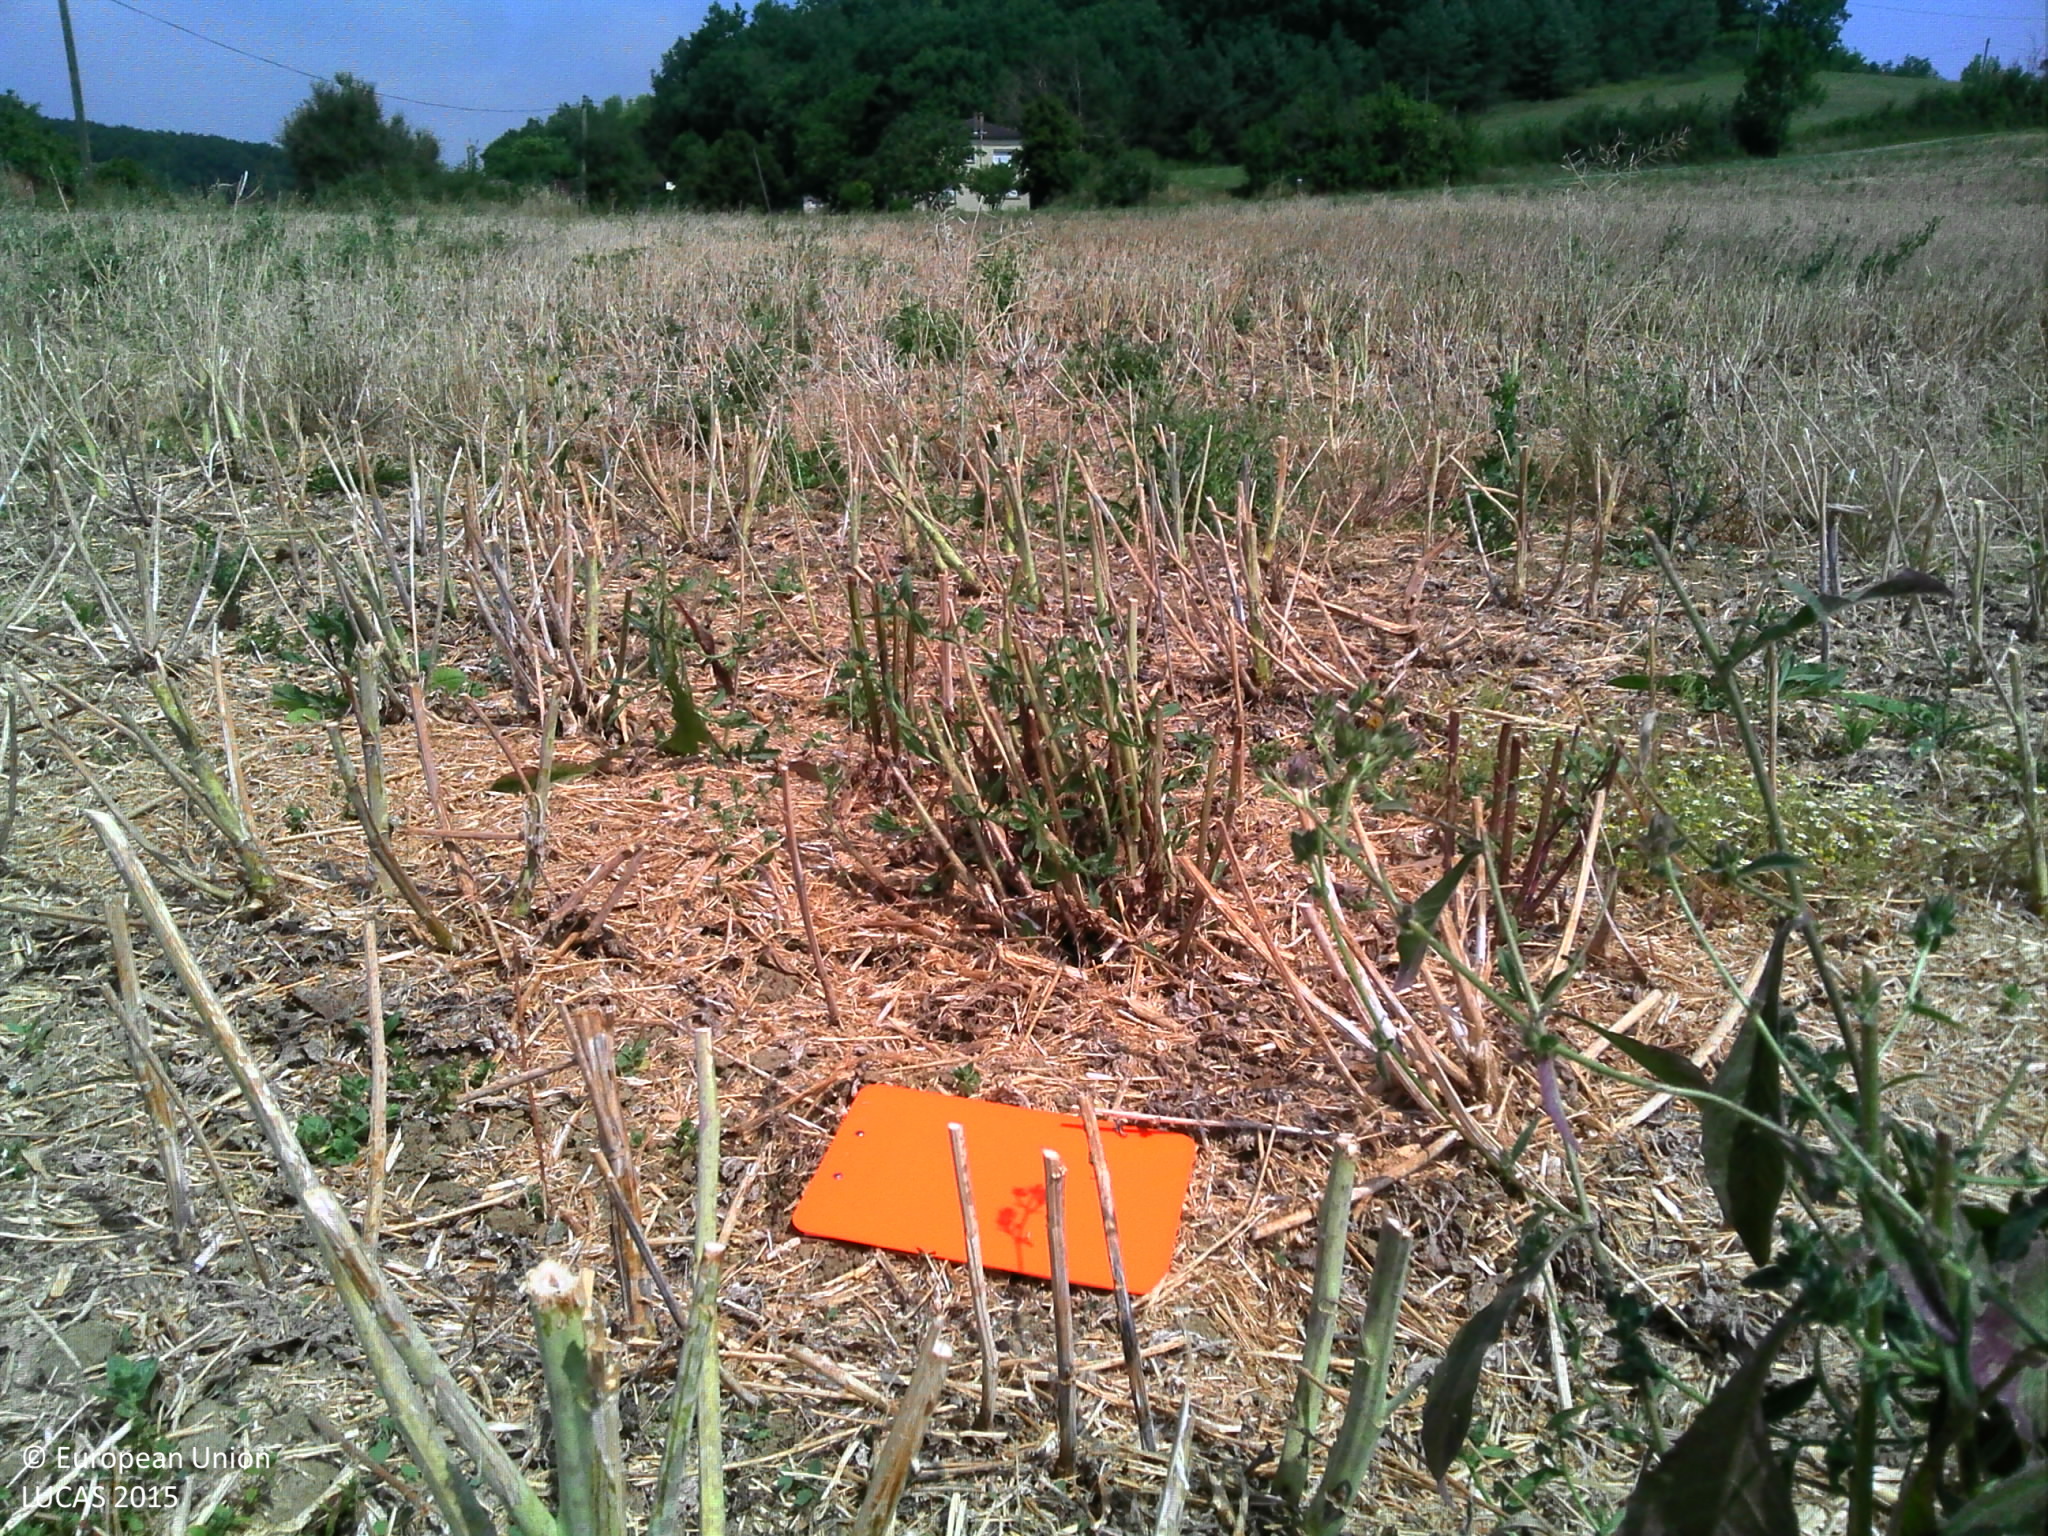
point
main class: Cropland
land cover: Rape and turnip rape
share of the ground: 10 - 25 %
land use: Agriculture (excluding fallow land and kitchen gardens)
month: July
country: FR
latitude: 44.2933
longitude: 0.8845
